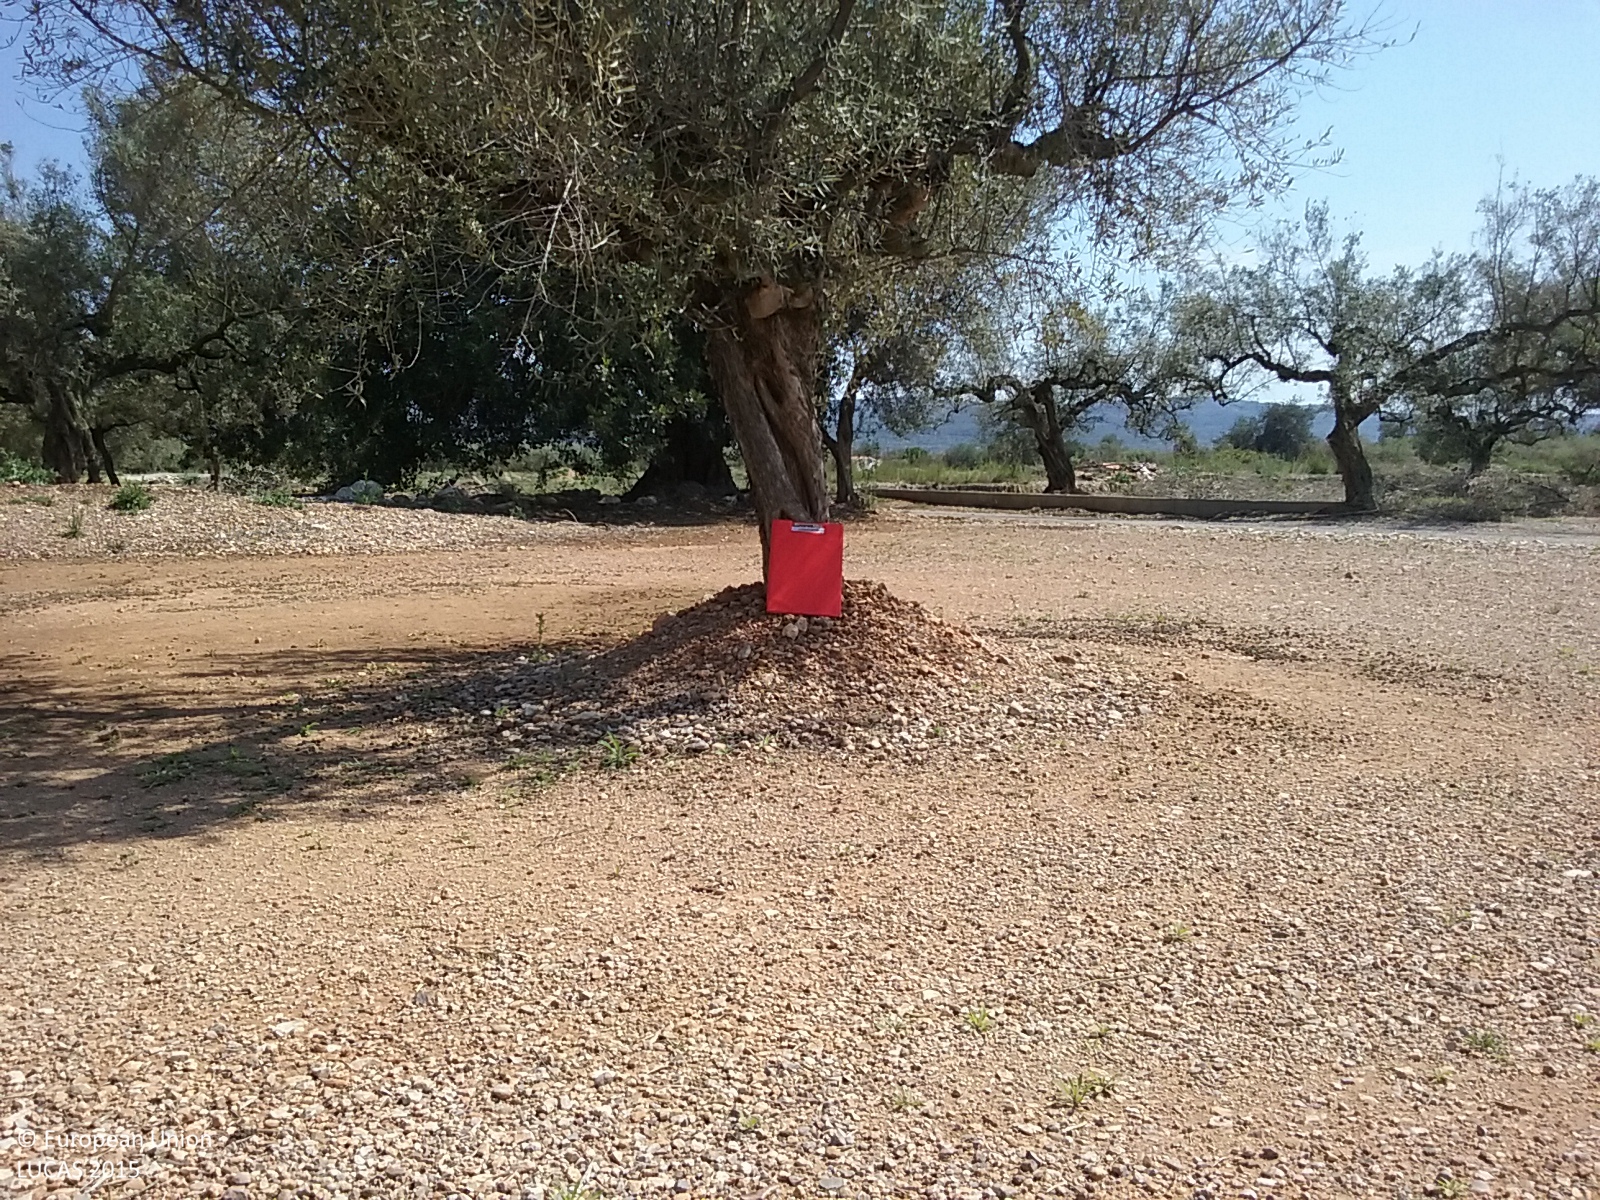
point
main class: Cropland
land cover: Olive groves
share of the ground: 10 - 25 %
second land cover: Other bare soil
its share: > 75 %
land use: Agriculture (excluding fallow land and kitchen gardens)
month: April
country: ES
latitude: 40.6919
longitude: 0.4449
